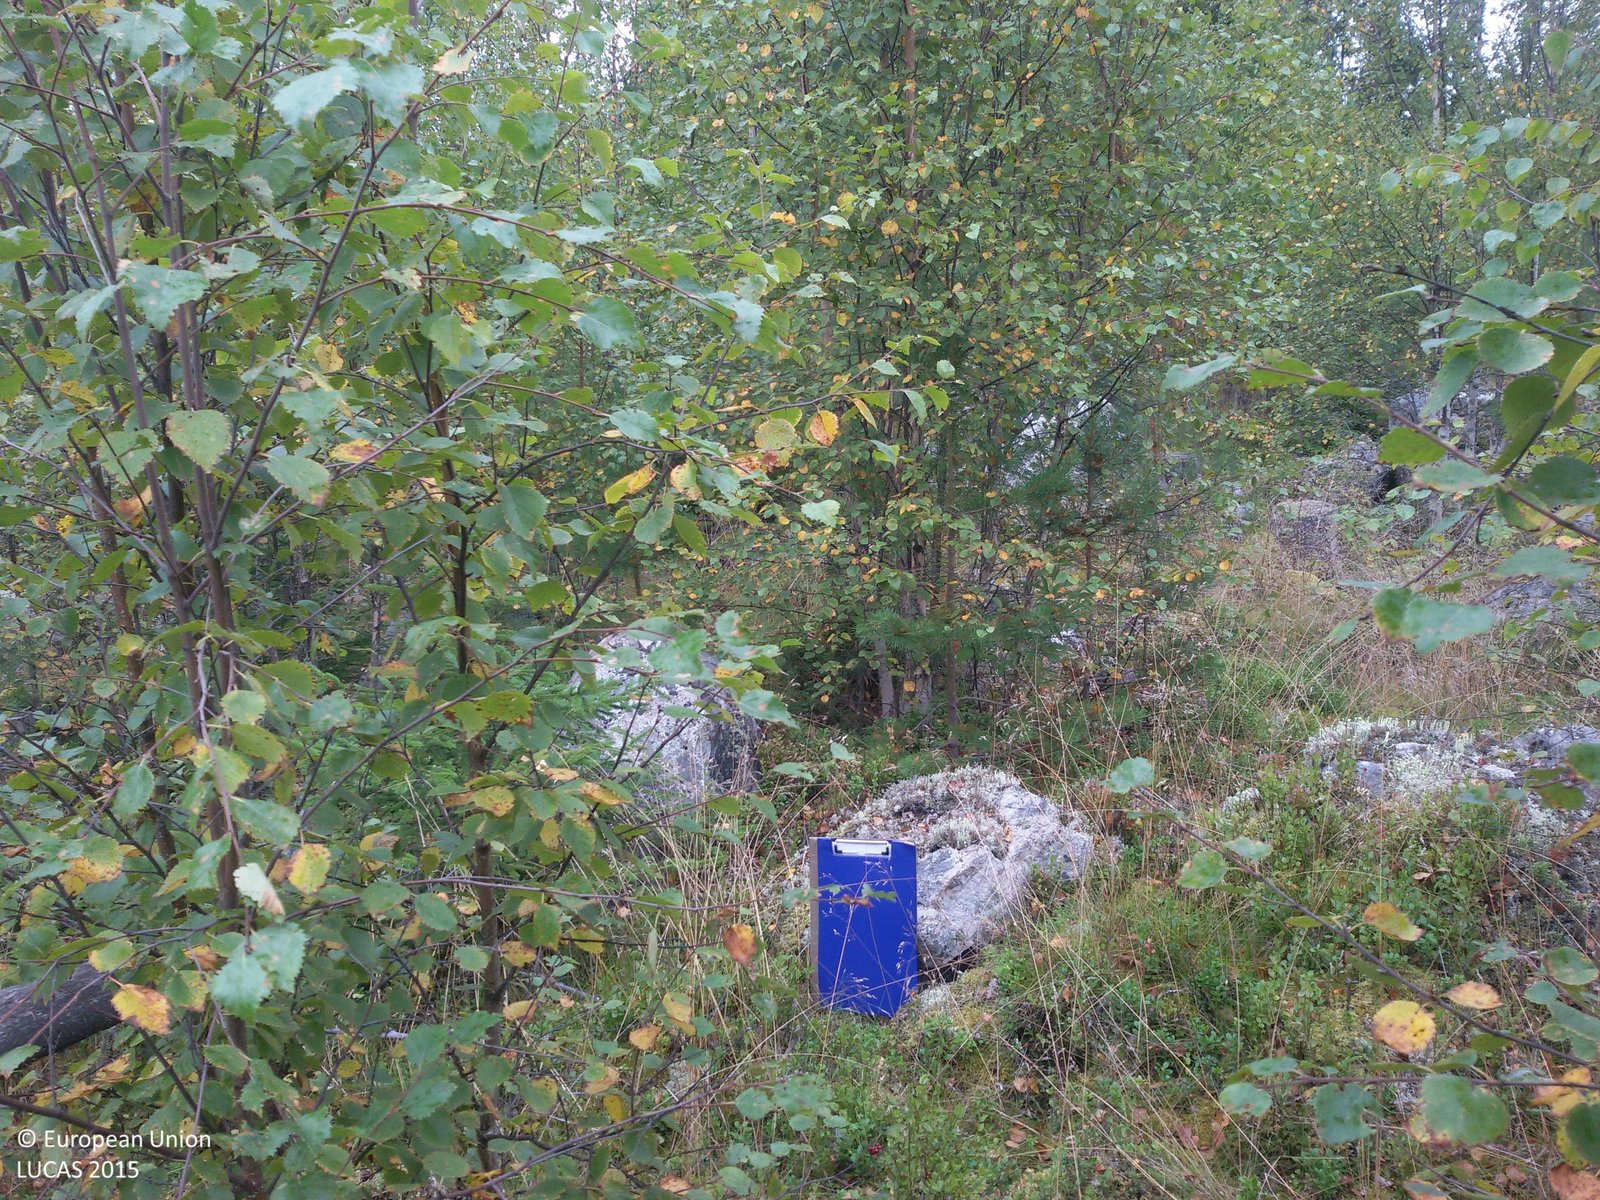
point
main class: Woodland
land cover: Pine dominated mixed woodland
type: boreal forest
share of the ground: 50 - 75 %
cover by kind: broadleaved forest trees 40 %, coniferous forest trees 30 %, herbaceous plants 20 %, lichens and mosses 10 %
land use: Forestry
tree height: < 5 m
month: September
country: SE
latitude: 60.8211
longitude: 15.3006
